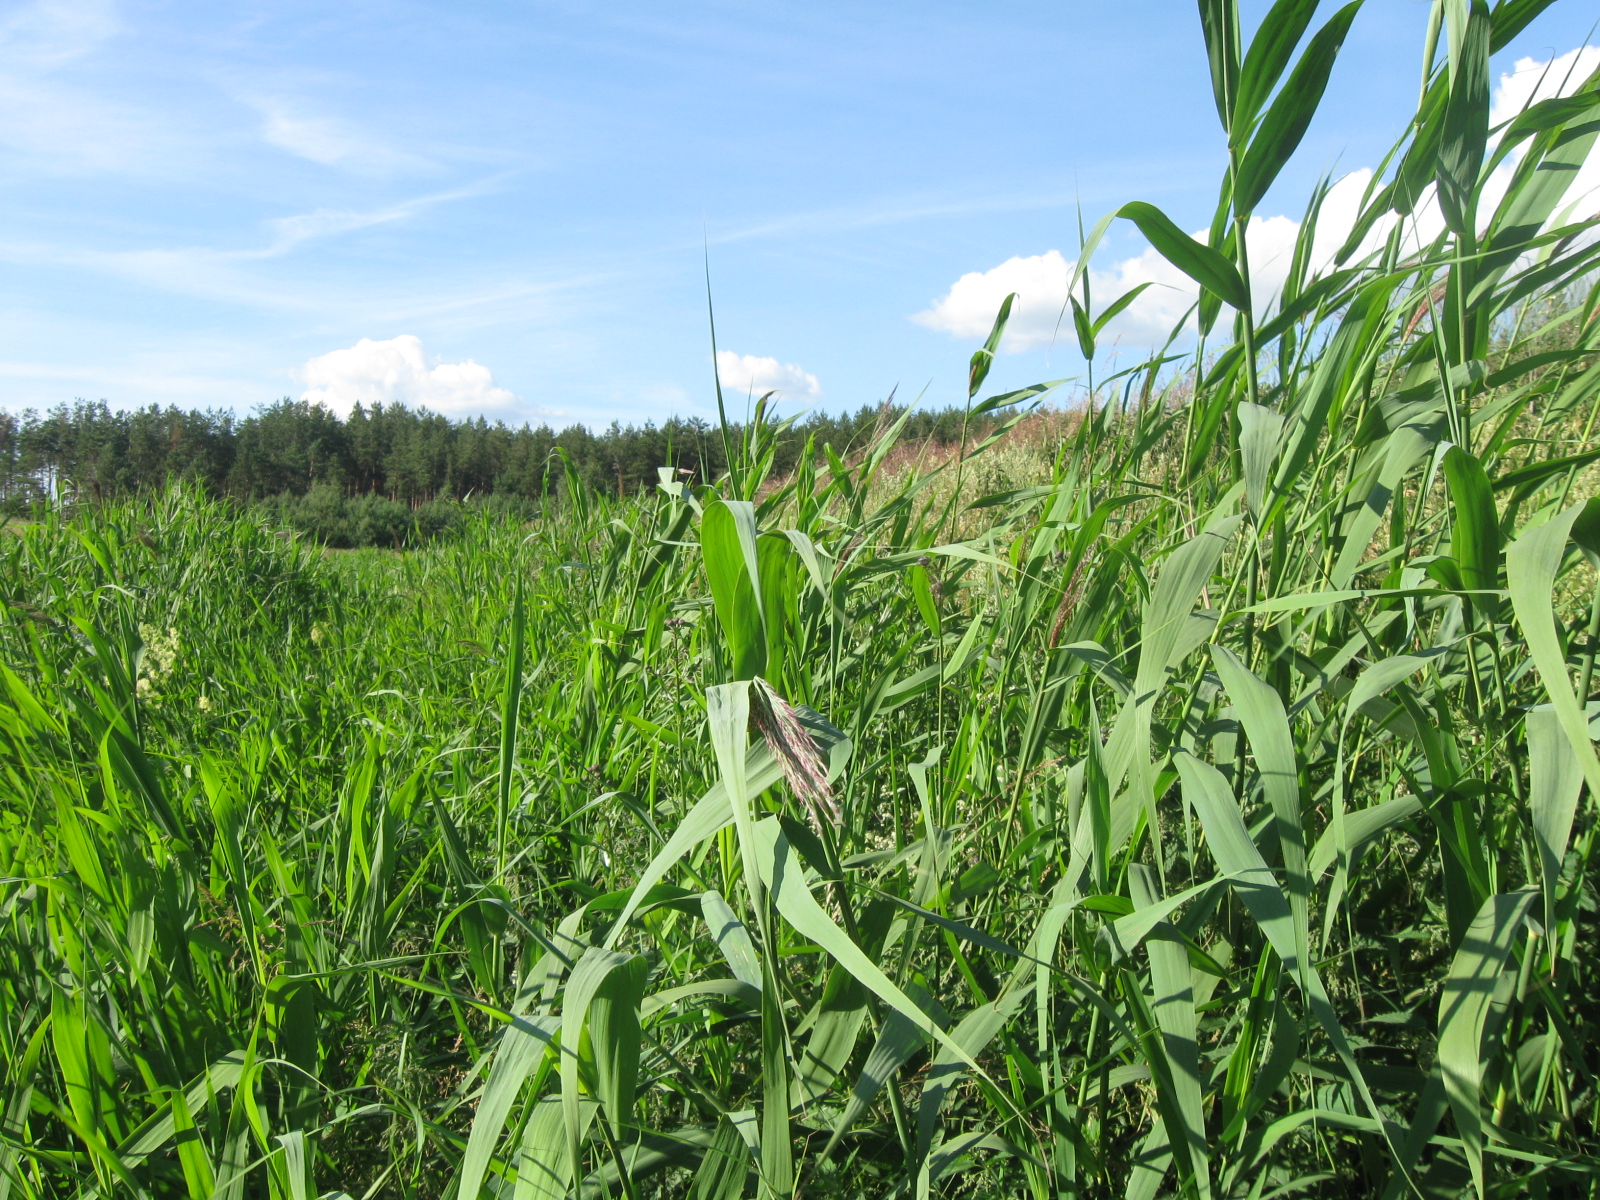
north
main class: Grassland
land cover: Spontaneously vegetated surfaces
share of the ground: > 75 %
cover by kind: herbaceous plants 100 %
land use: Semi-natural and natural areas not in use
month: July
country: LT
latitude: 54.2618
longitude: 24.3312
